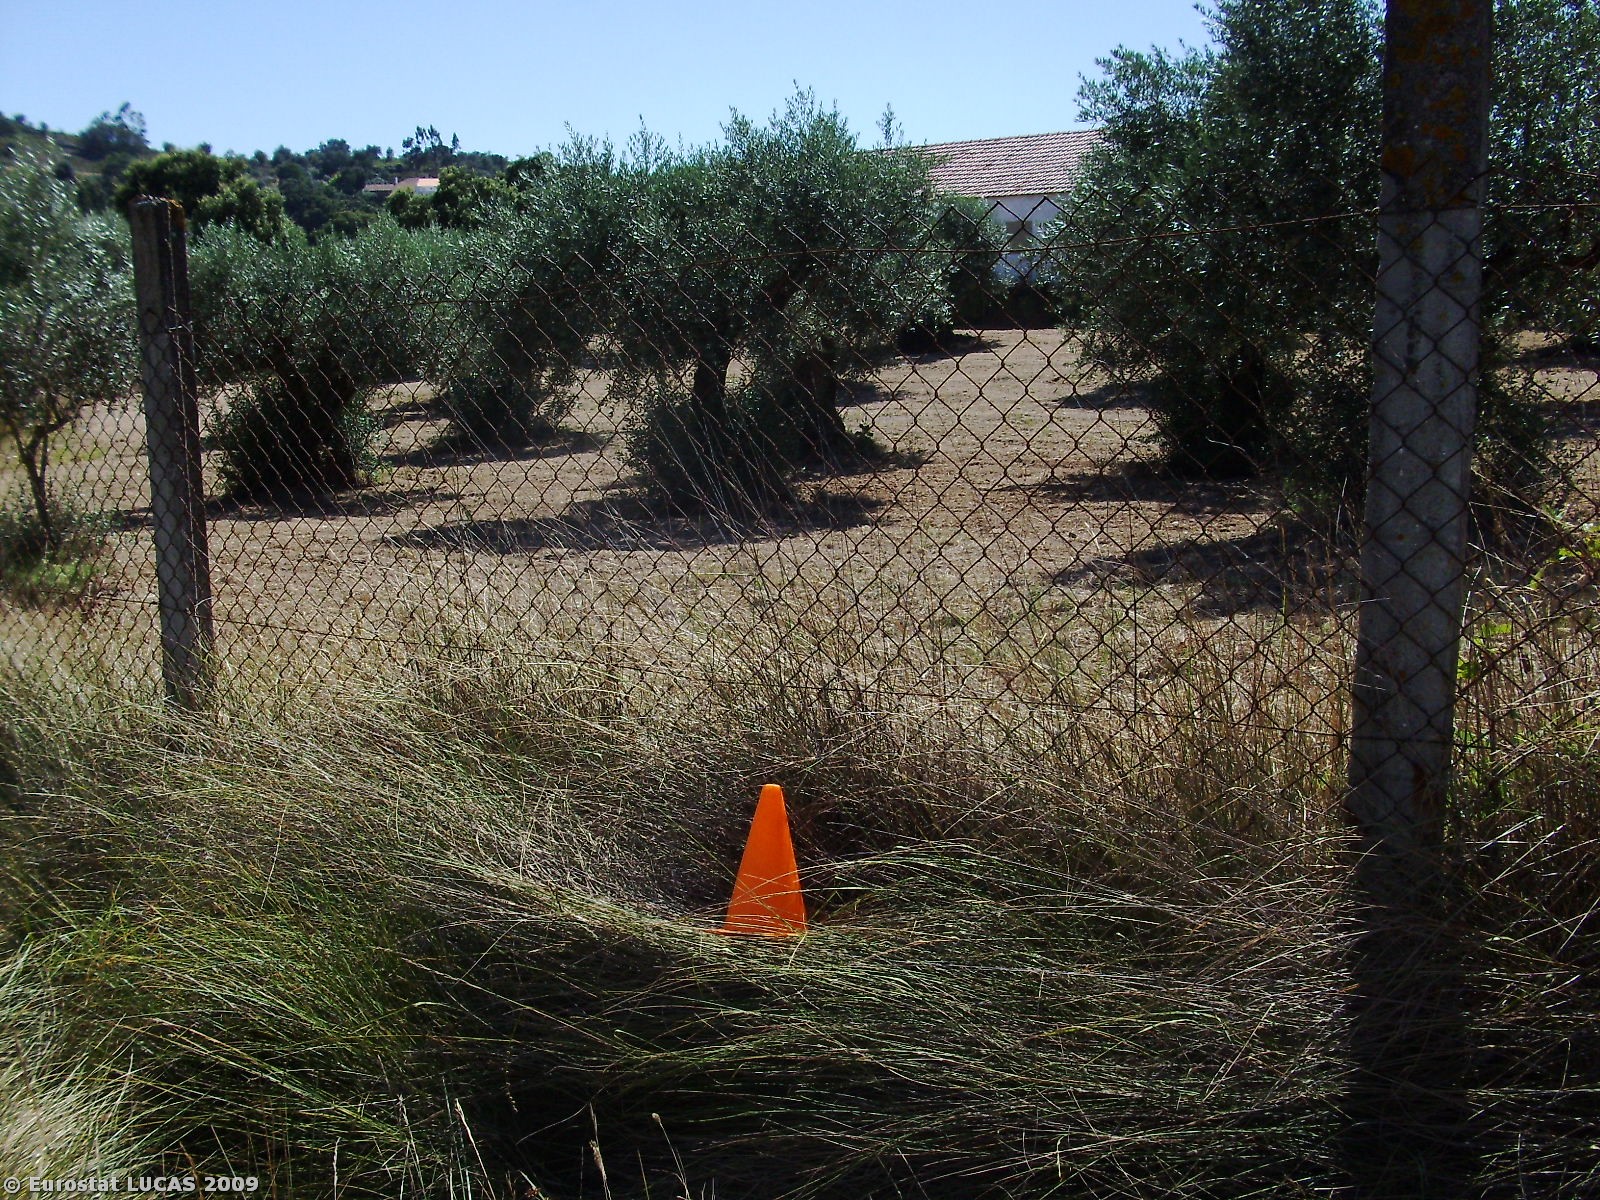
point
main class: Grassland
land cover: Spontaneously vegetated surfaces
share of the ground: > 75 %
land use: Fallow land
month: July
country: PT
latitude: 39.4190
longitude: -8.7678
